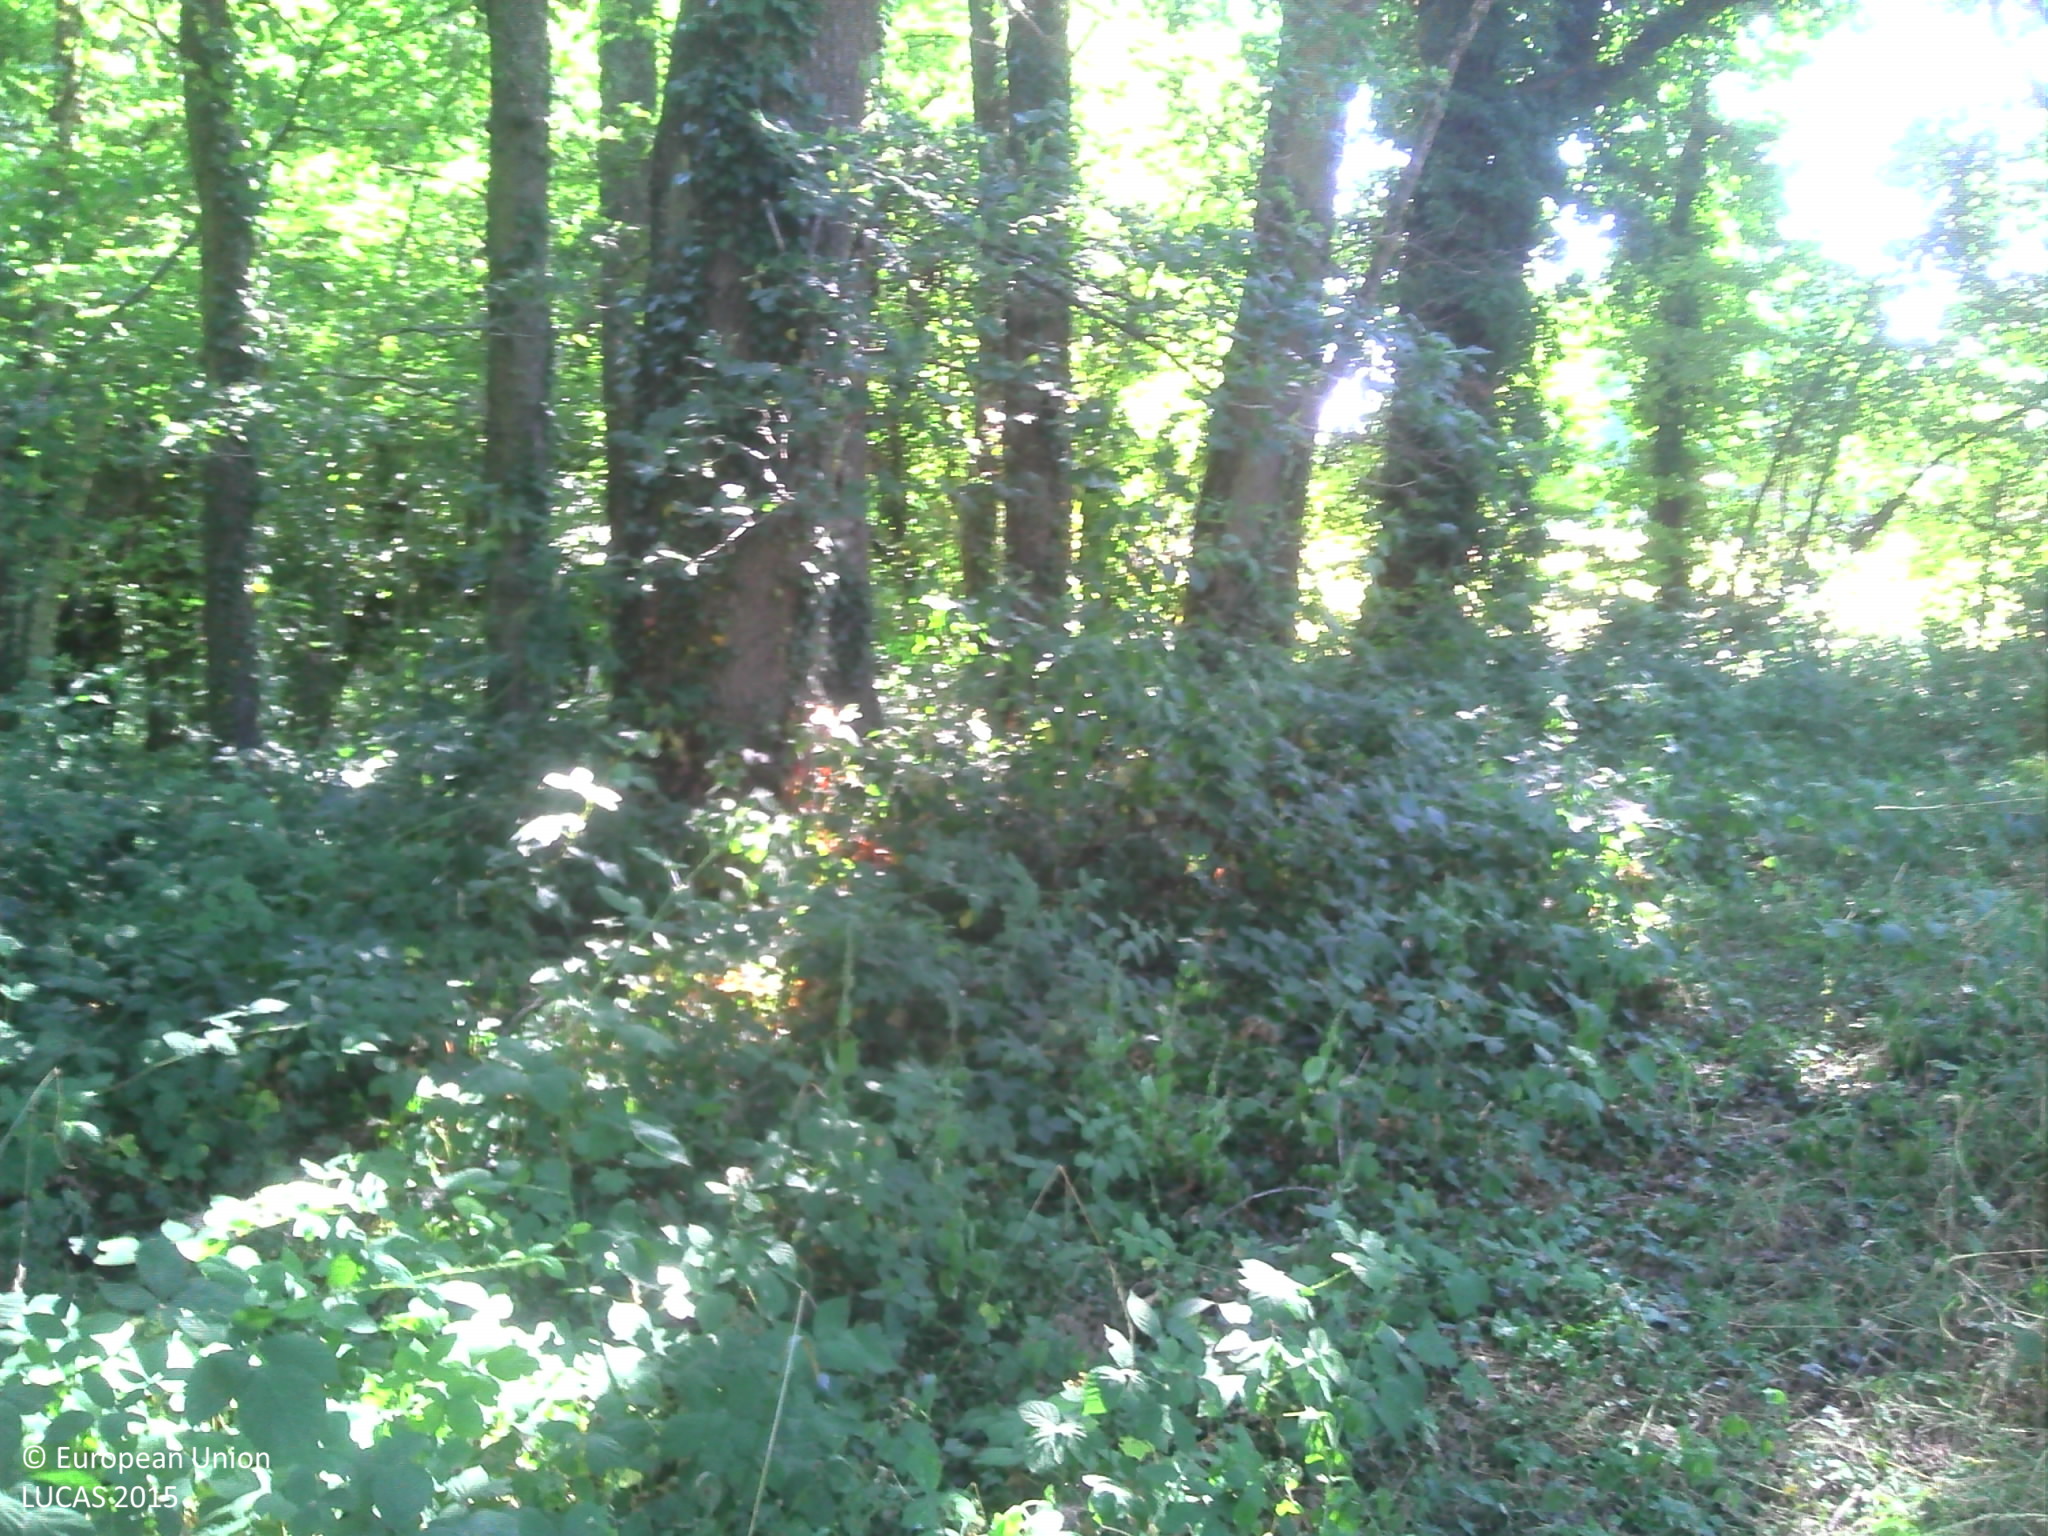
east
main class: Woodland
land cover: Broadleaved woodland
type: acidophilous oak and oak-birch forest
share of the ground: > 75 %
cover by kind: broadleaved forest trees 70 %, herbaceous plants 30 %
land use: Forestry
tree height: > 5 m
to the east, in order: Broadleaved woodland; Electric lines; Grassland without tree/shrub cover; Fences; Grassland without tree/shrub cover; Fences; Electric lines; Grass margins; Grassland with sparse tree/shrub cover; Electric lines; Grassland with sparse tree/shrub cover; Groves; Spontaneously vegetated surfaces
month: July
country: FR
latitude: 46.7438
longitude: 5.0934
